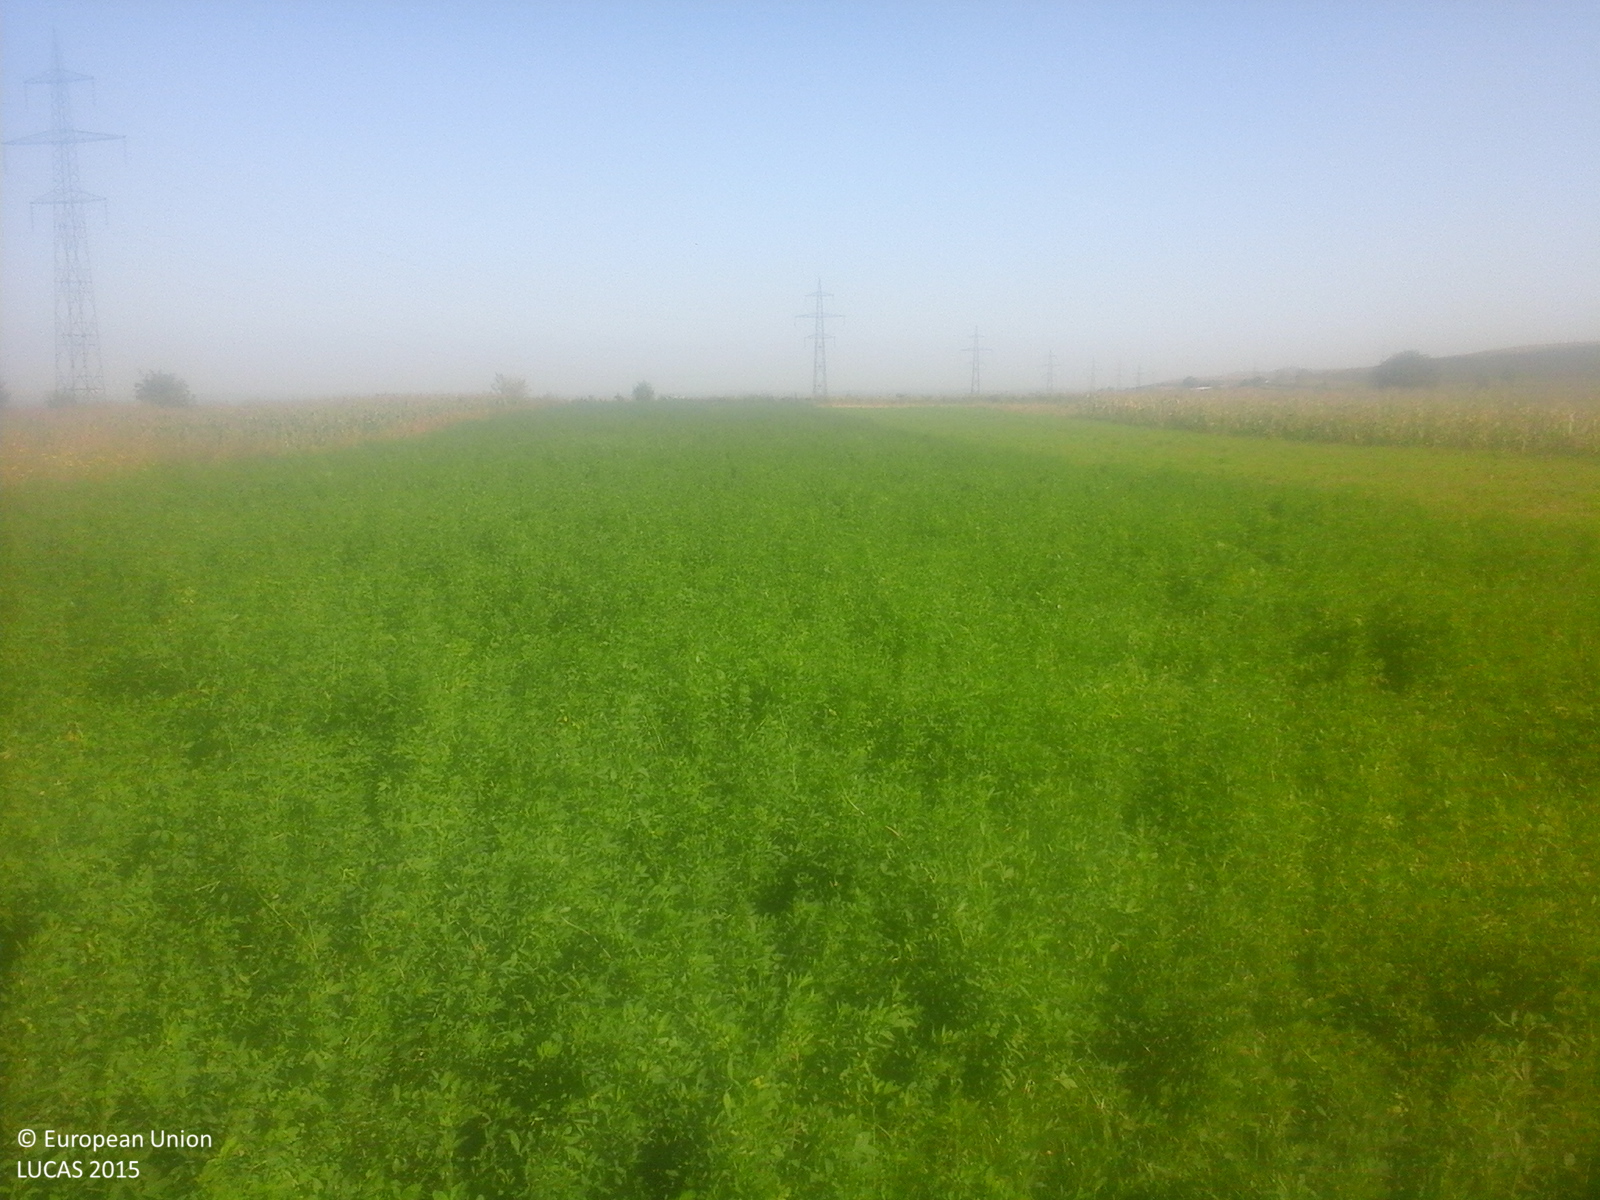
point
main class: Cropland
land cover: Lucerne
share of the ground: > 75 %
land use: Agriculture (excluding fallow land and kitchen gardens)
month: October
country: RO
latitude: 46.5034
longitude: 23.7151
